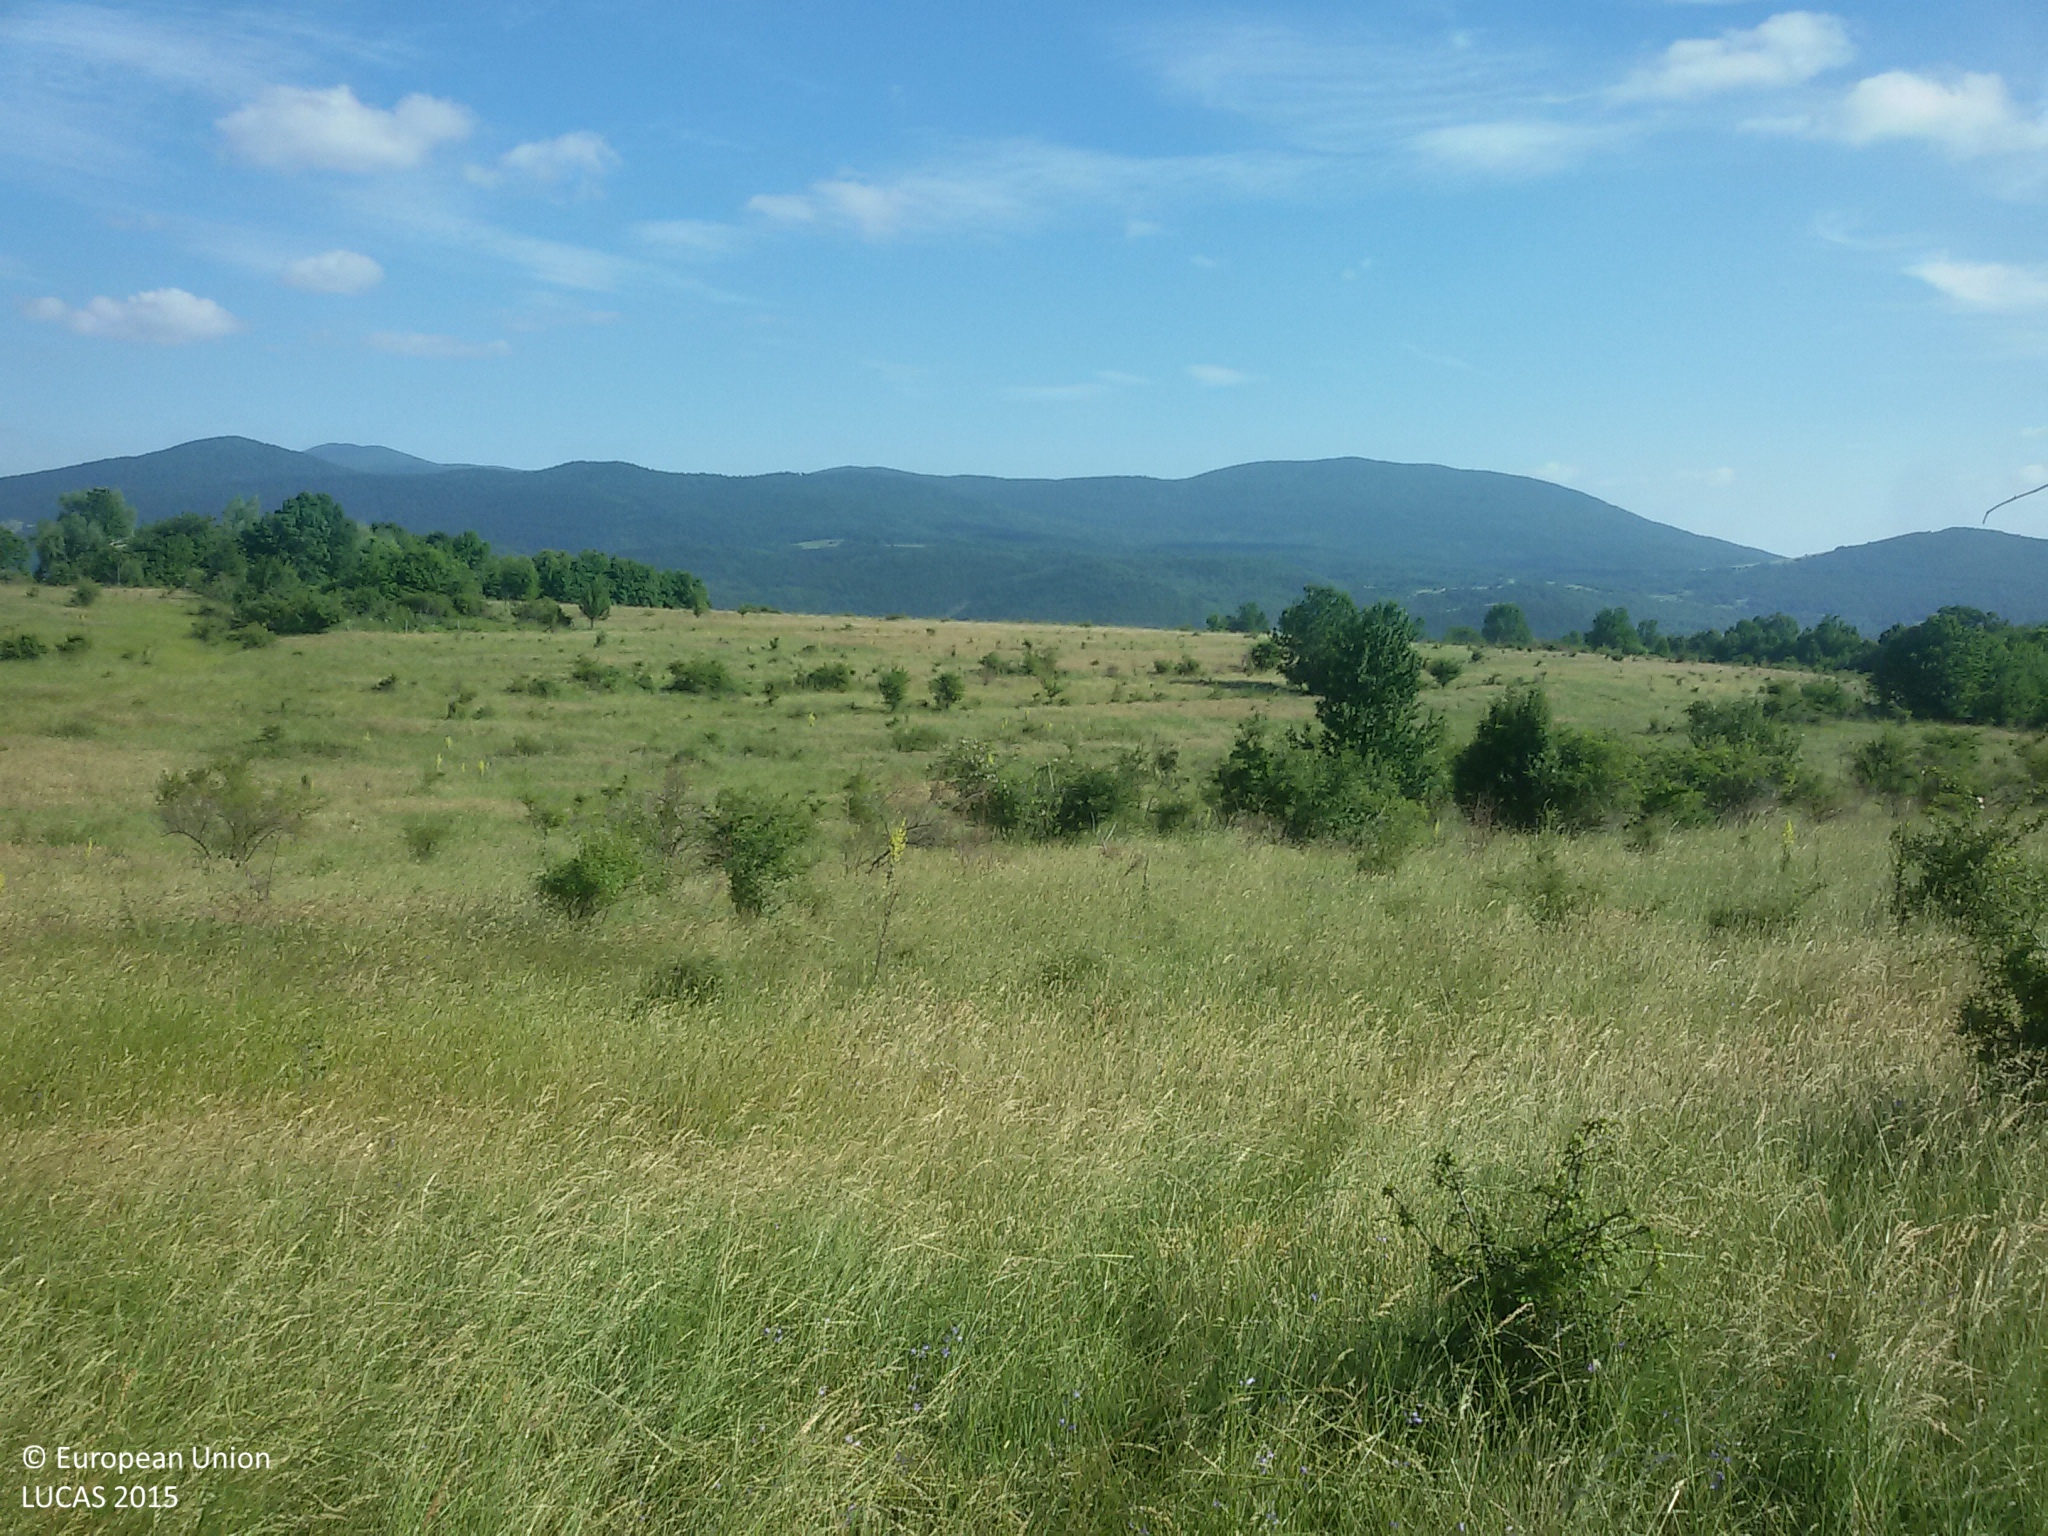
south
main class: Grassland
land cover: Grassland with sparse tree/shrub cover
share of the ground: > 75 %
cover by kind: herbaceous plants 85 %, broadleaved forest trees 5 %, shrubs 5 %, unconsolidated bare surface 5 %
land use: Semi-natural and natural areas not in use
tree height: < 5 m
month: June
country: HR
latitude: 44.5487
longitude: 15.8218
